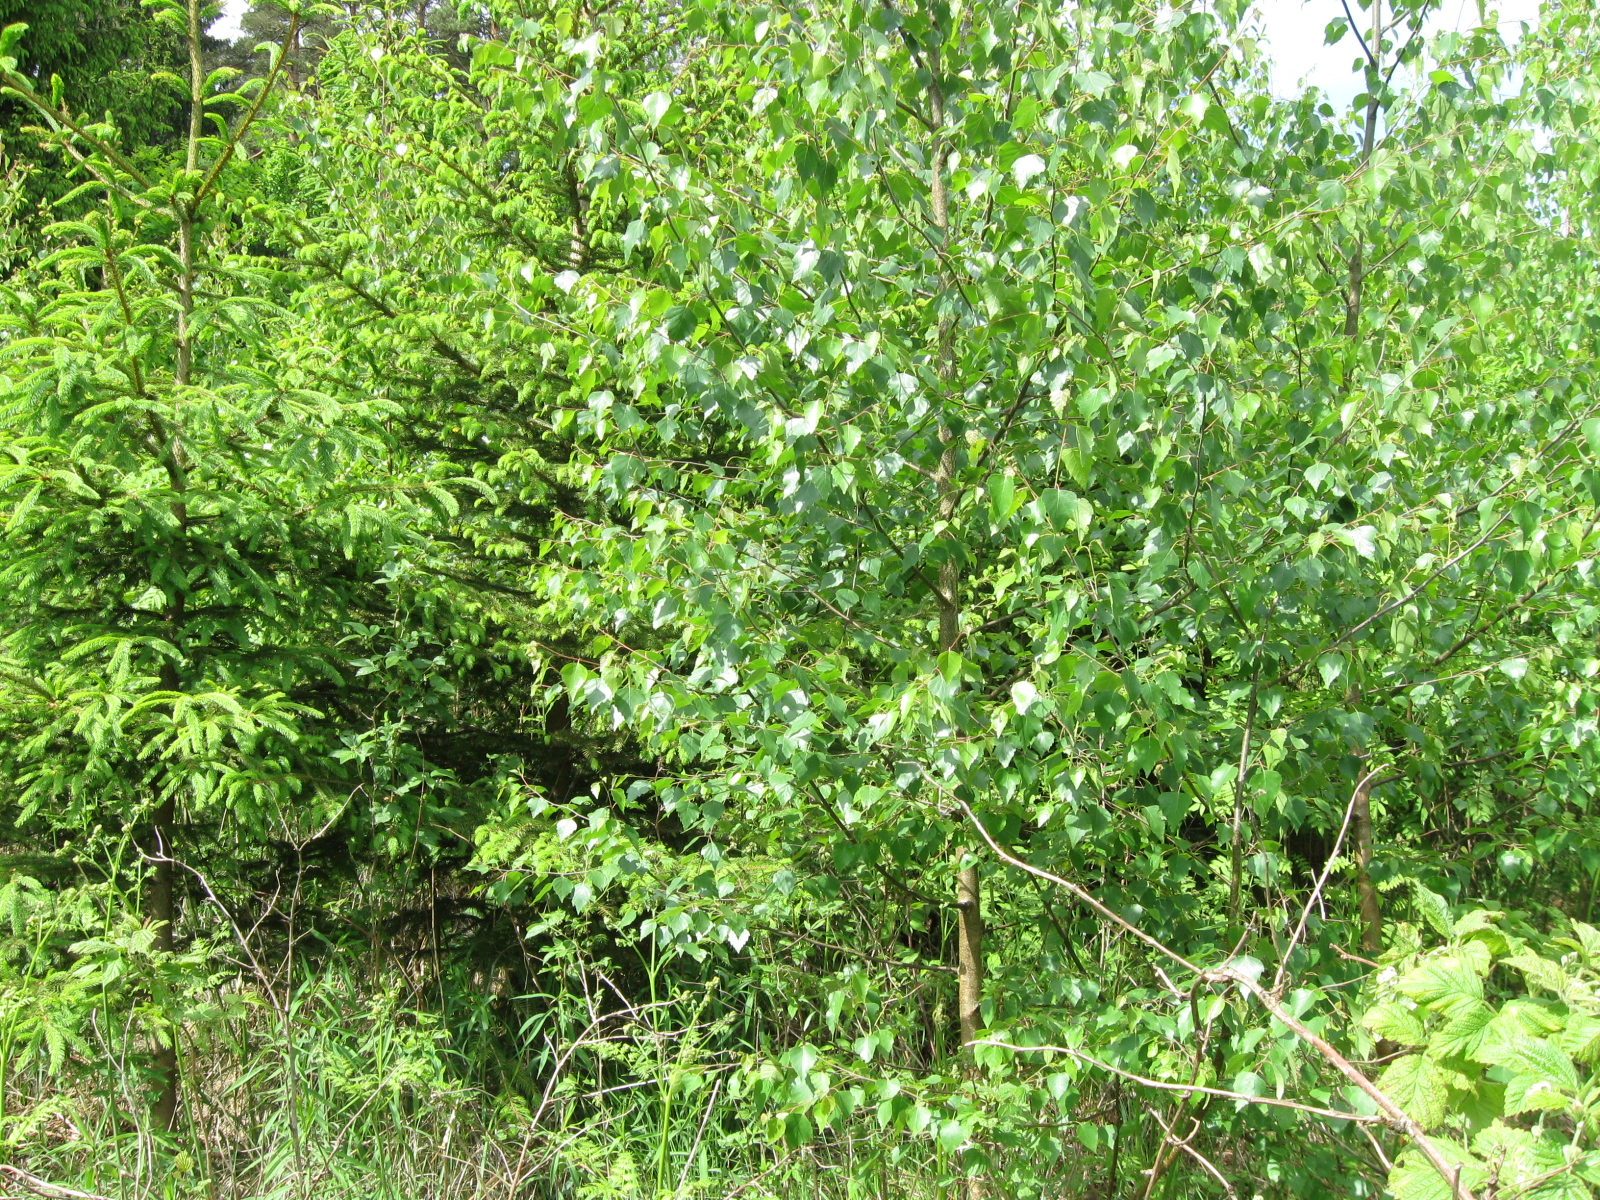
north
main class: Woodland
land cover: Spruce dominated mixed woodland
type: hemiboreal forest and nemoral coniferous forest and mixed broadleaved-coniferous forest
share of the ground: > 75 %
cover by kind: coniferous forest trees 30 %, broadleaved forest trees 30 %, herbaceous plants 30 %, shrubs 10 %
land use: Forestry
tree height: < 5 m
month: June
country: LT
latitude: 54.6410
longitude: 23.8954
